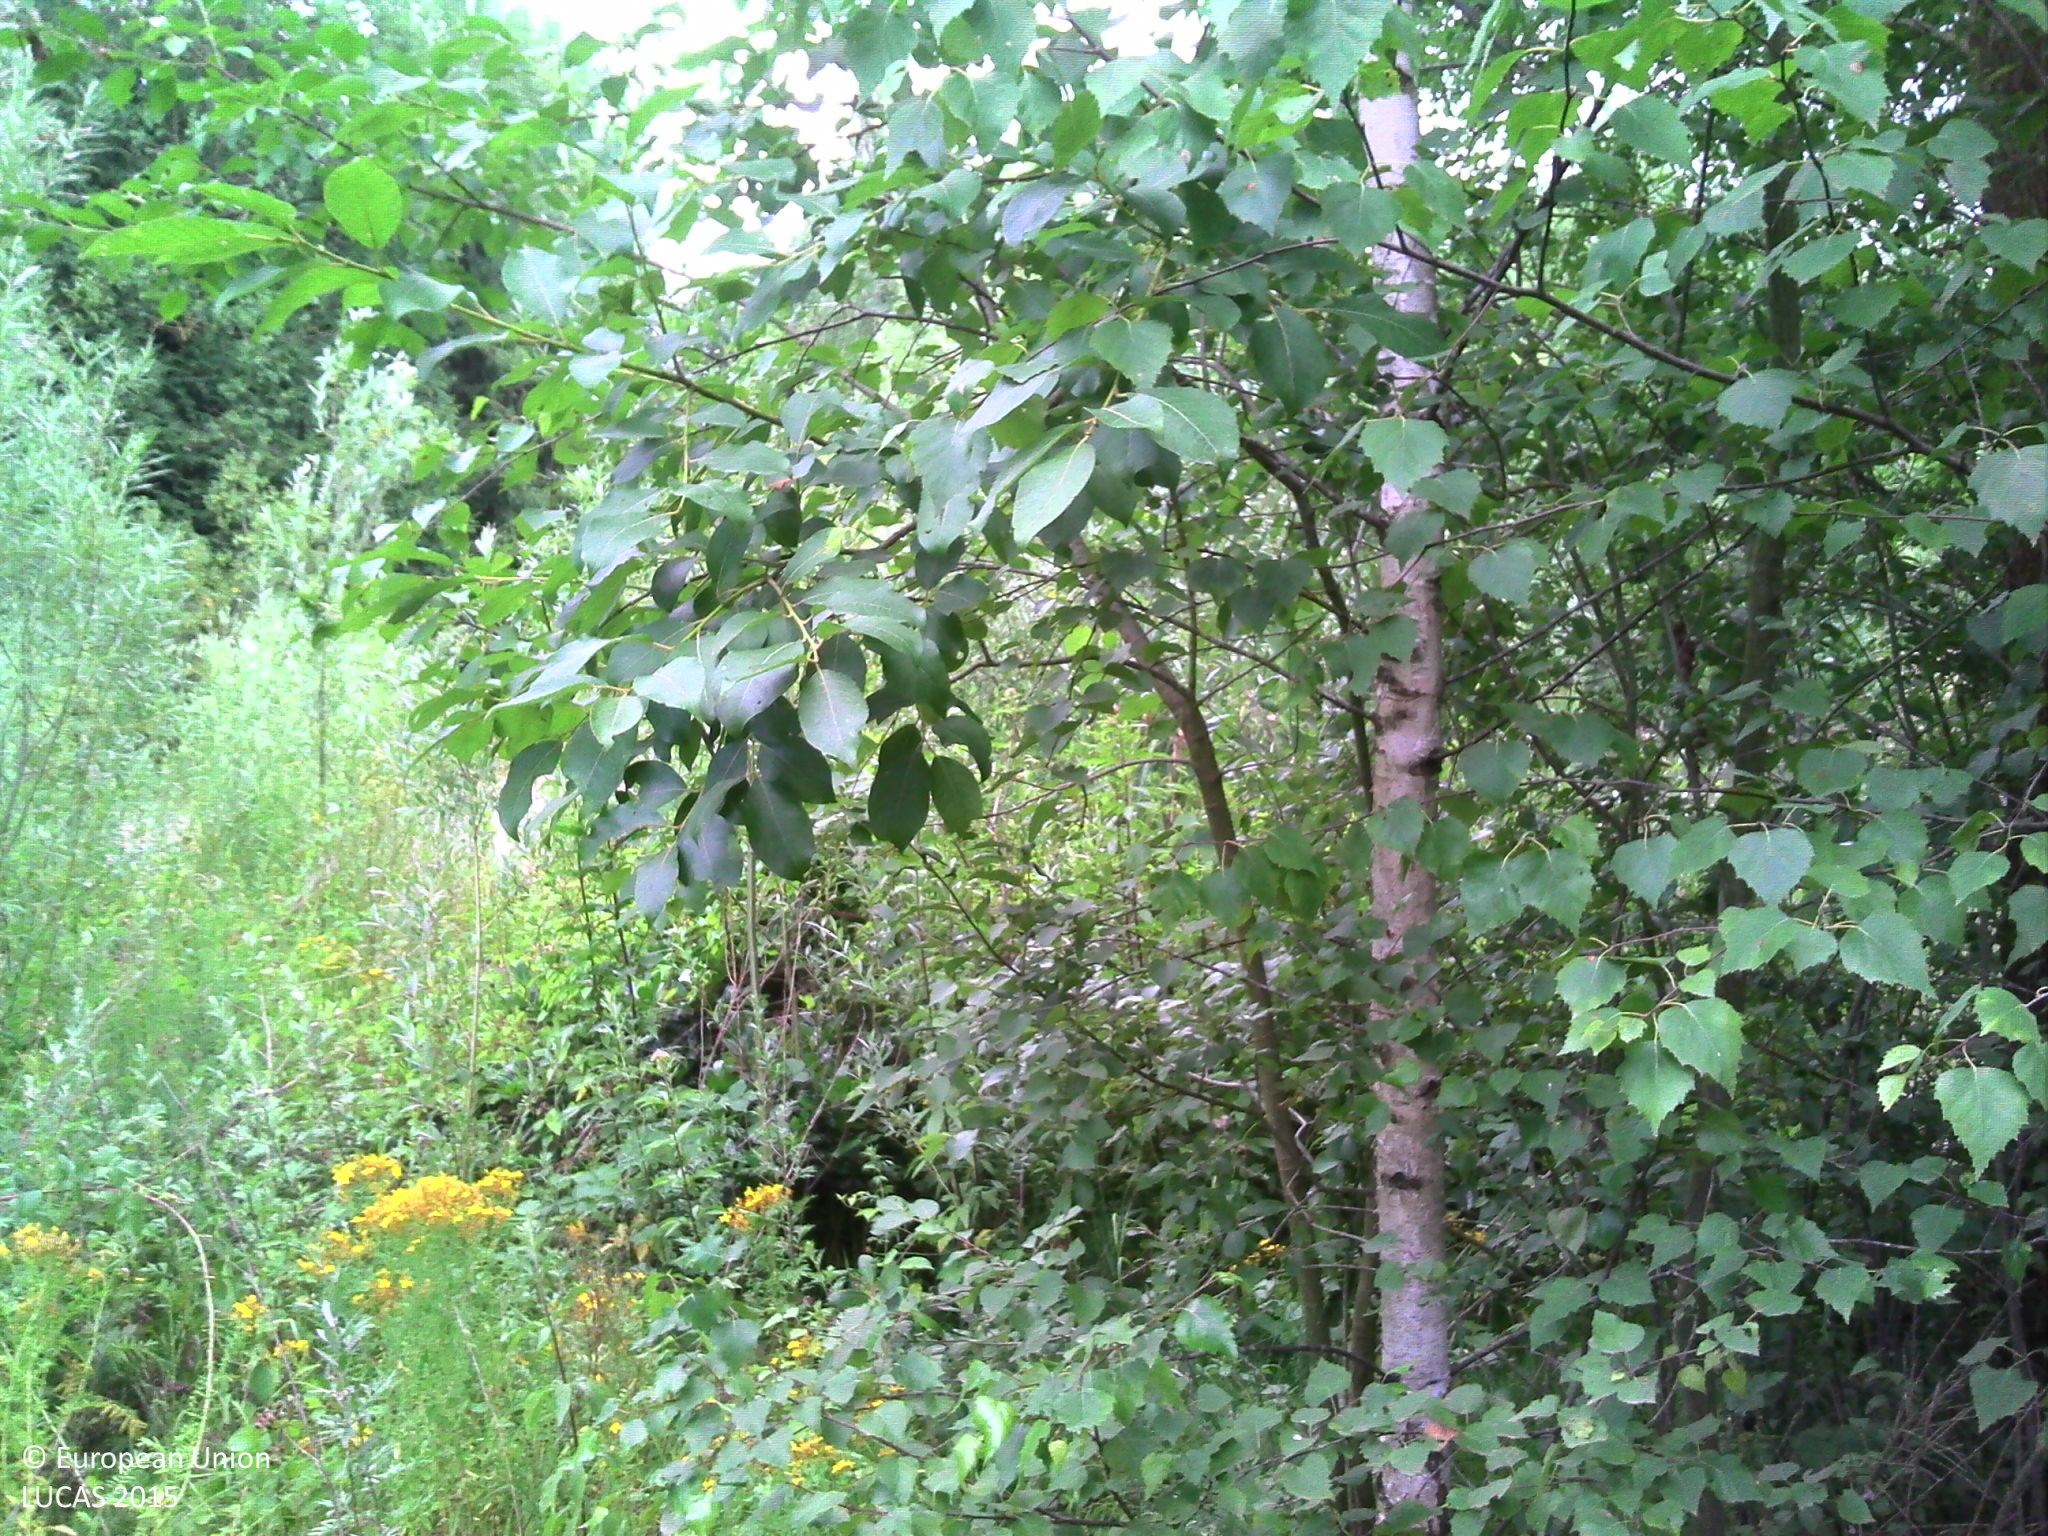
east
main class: Woodland
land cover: Broadleaved woodland
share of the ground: > 75 %
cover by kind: broadleaved forest trees 70 %, herbaceous plants 30 %
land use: Semi-natural and natural areas not in use
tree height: > 5 m
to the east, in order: Broadleaved woodland; Spontaneously vegetated surfaces; Tracks; Broadleaved woodland; Grassland without tree/shrub cover; Broadleaved woodland; Tracks; Broadleaved woodland; Fences; Broadleaved woodland; Grassland without tree/shrub cover
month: July
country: BE
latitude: 50.5591
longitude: 4.5613
